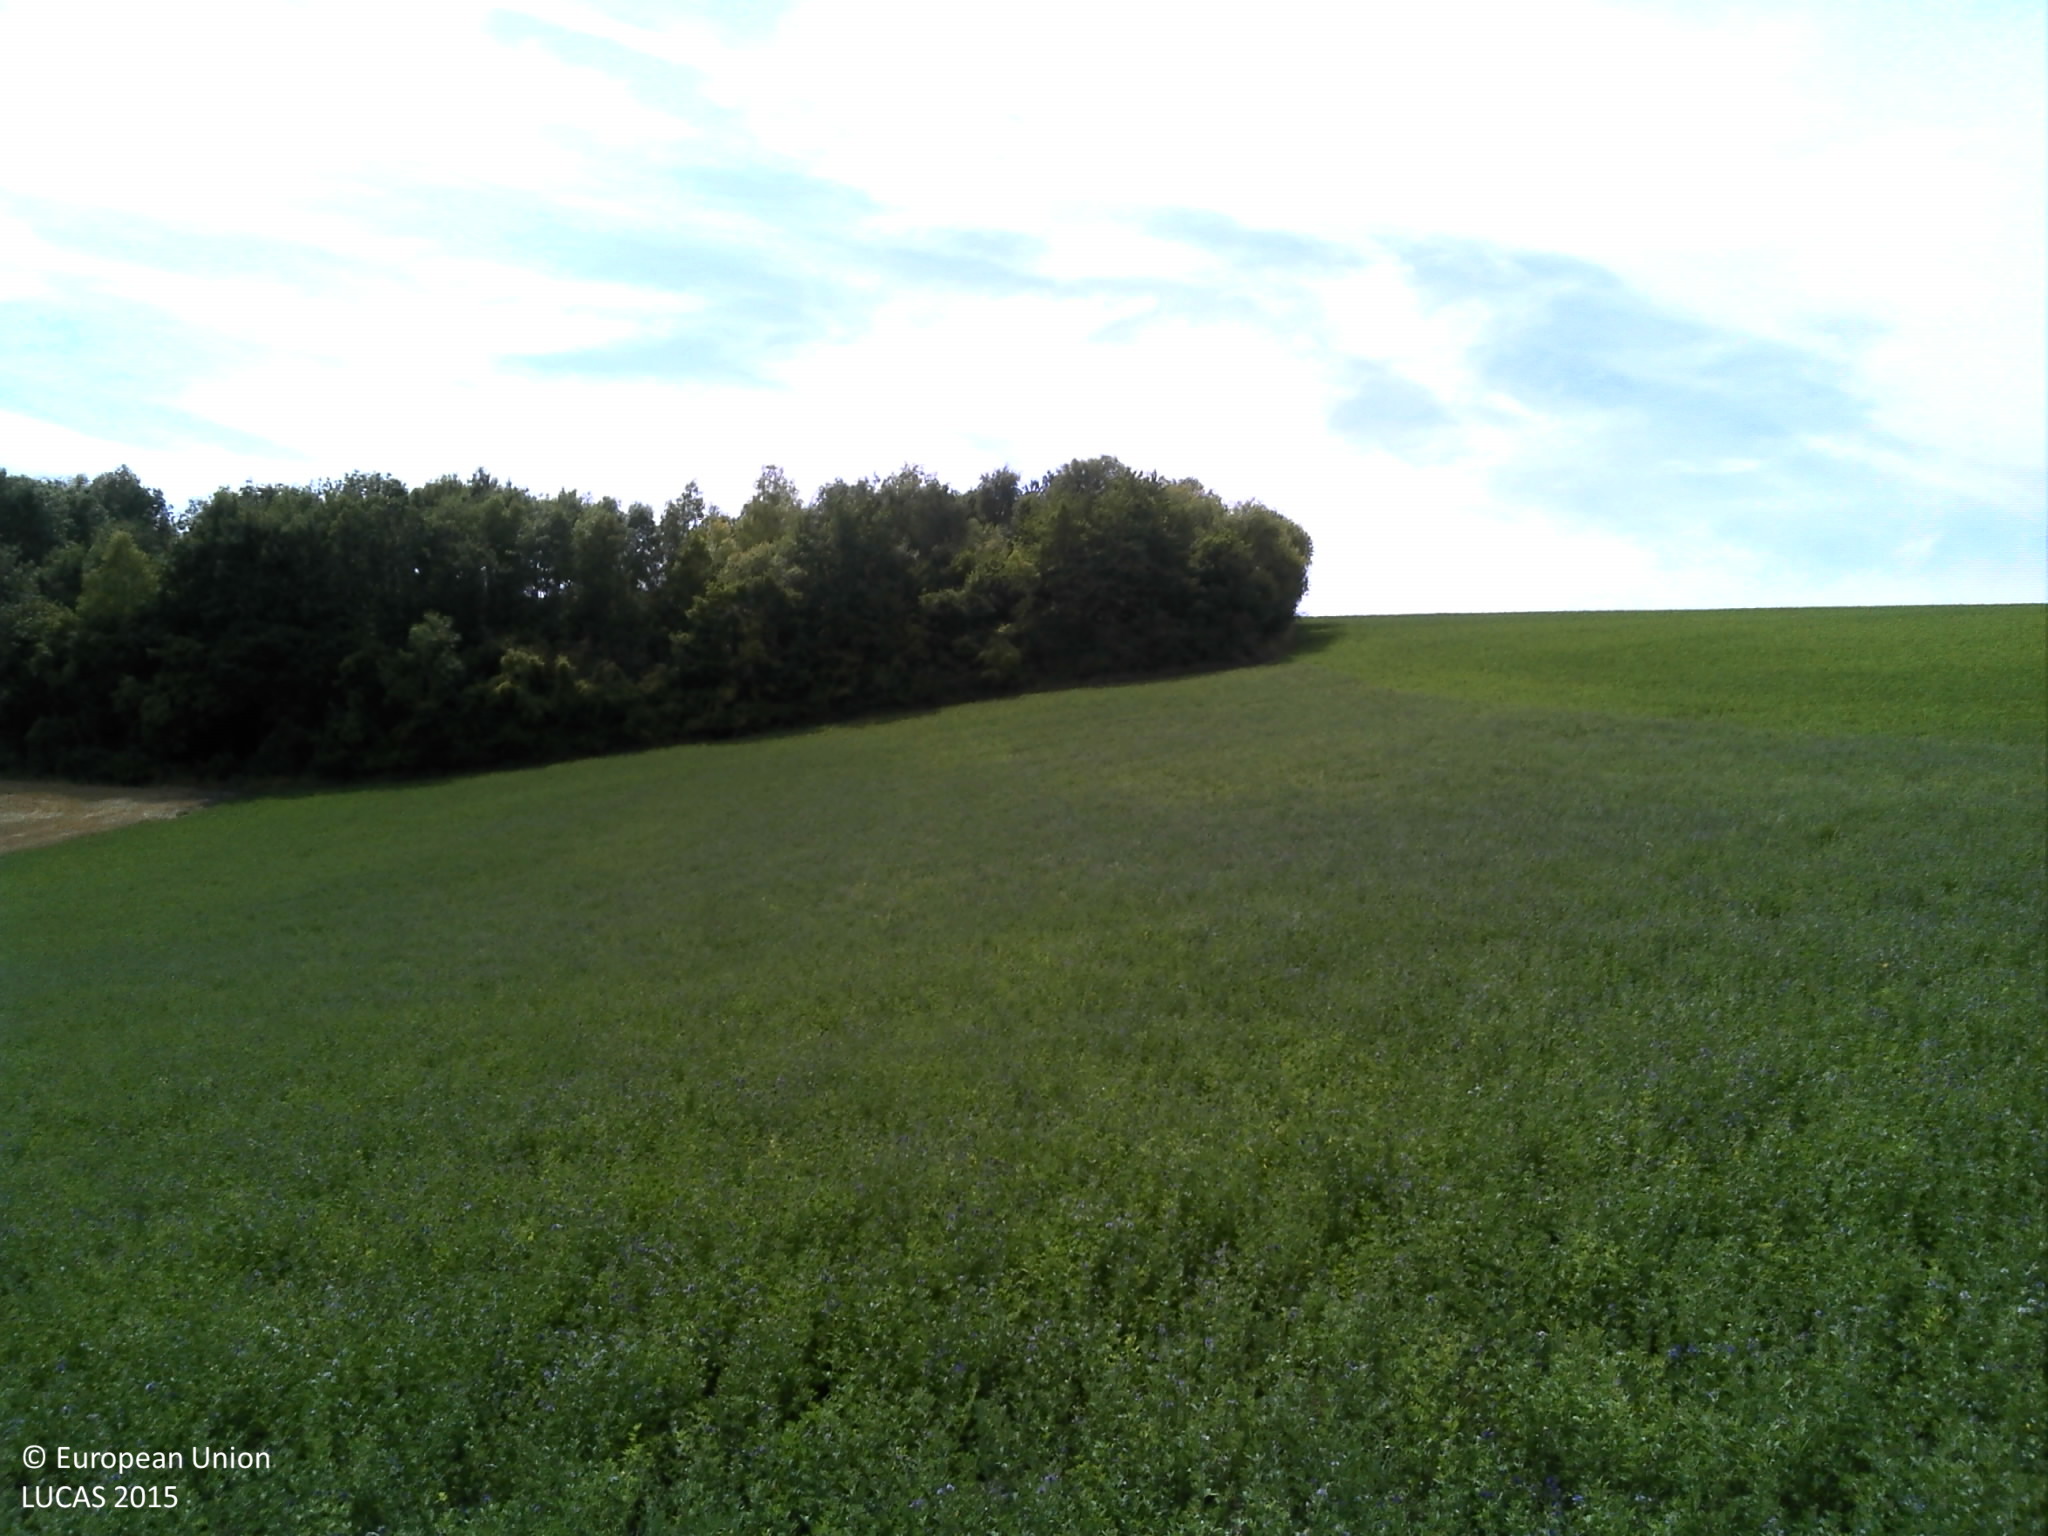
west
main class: Cropland
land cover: Lucerne
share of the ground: > 75 %
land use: Agriculture (excluding fallow land and kitchen gardens)
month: August
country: FR
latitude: 49.0197
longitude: 4.7875
